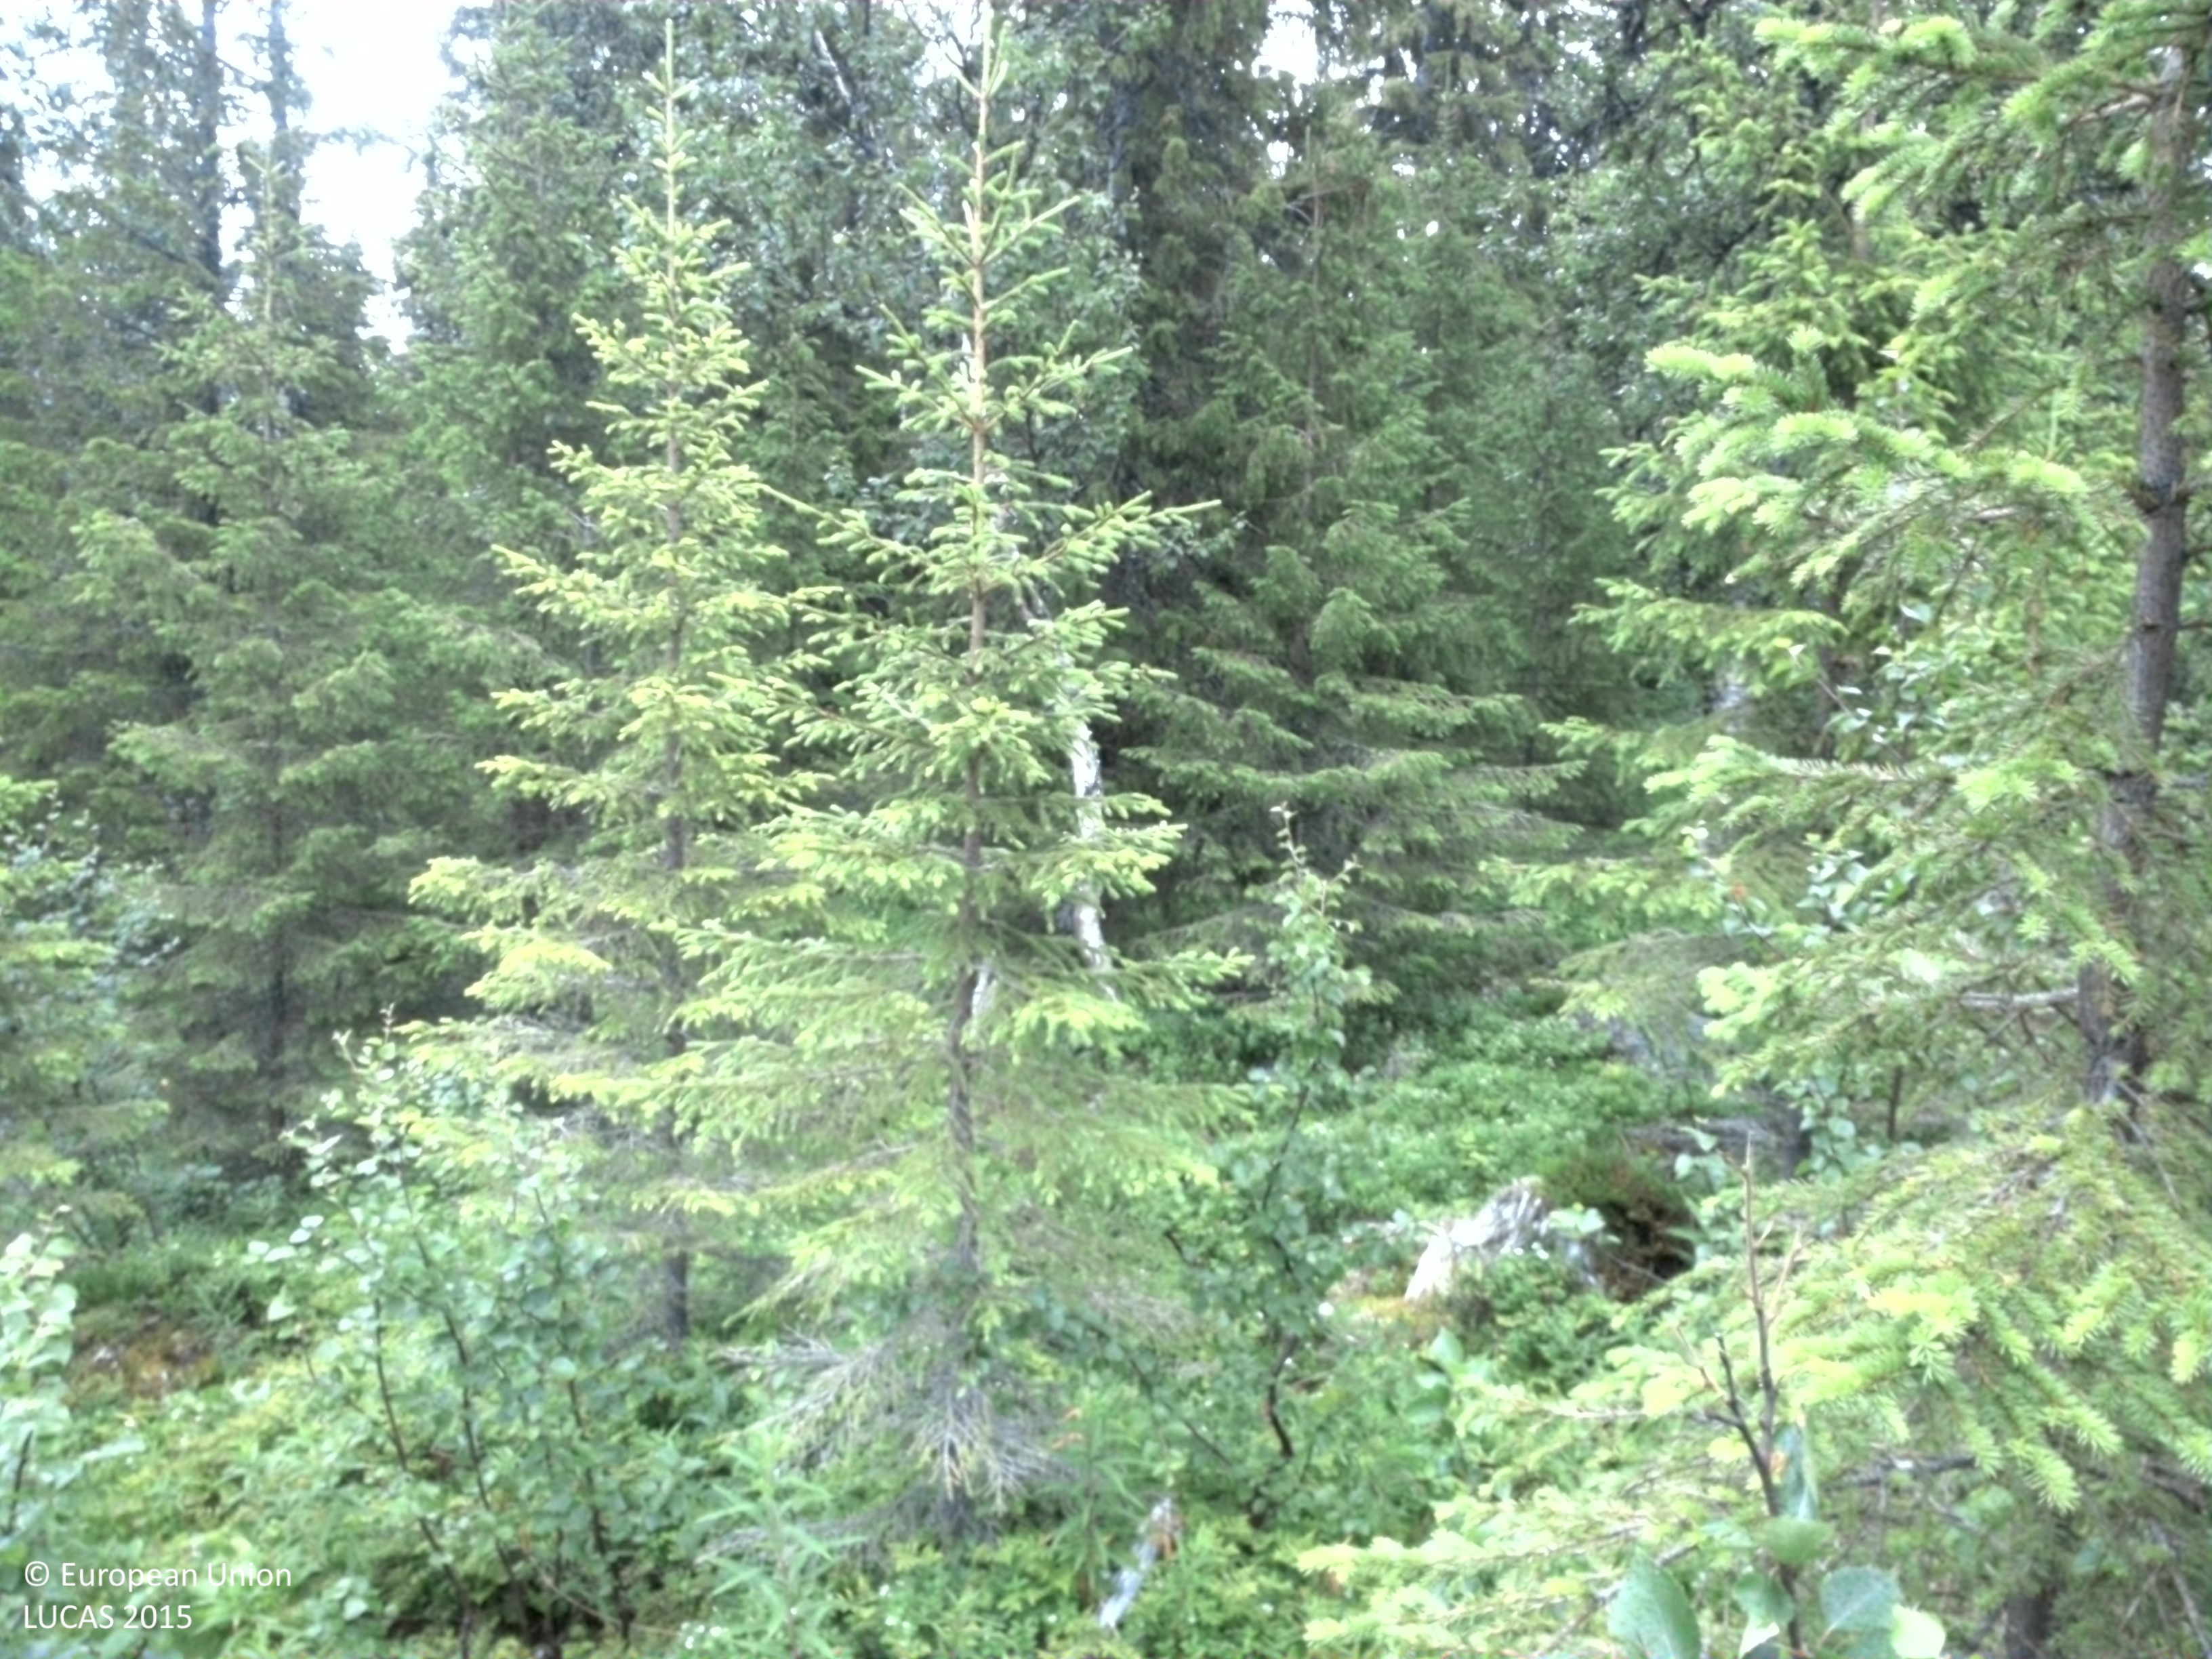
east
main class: Woodland
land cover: Spruce dominated mixed woodland
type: boreal forest
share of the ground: 25 - 50 %
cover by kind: herbaceous plants 30 %, coniferous forest trees 25 %, shrubs 25 %, broadleaved forest trees 10 %, lichens and mosses 10 %
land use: Forestry
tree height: < 5 m
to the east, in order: Spruce dominated mixed woodland; Spruce dominated coniferous woodland; Rivers and streams; Spruce dominated coniferous woodland; Spruce dominated mixed woodland
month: August
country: SE
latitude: 64.9715
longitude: 15.5389
